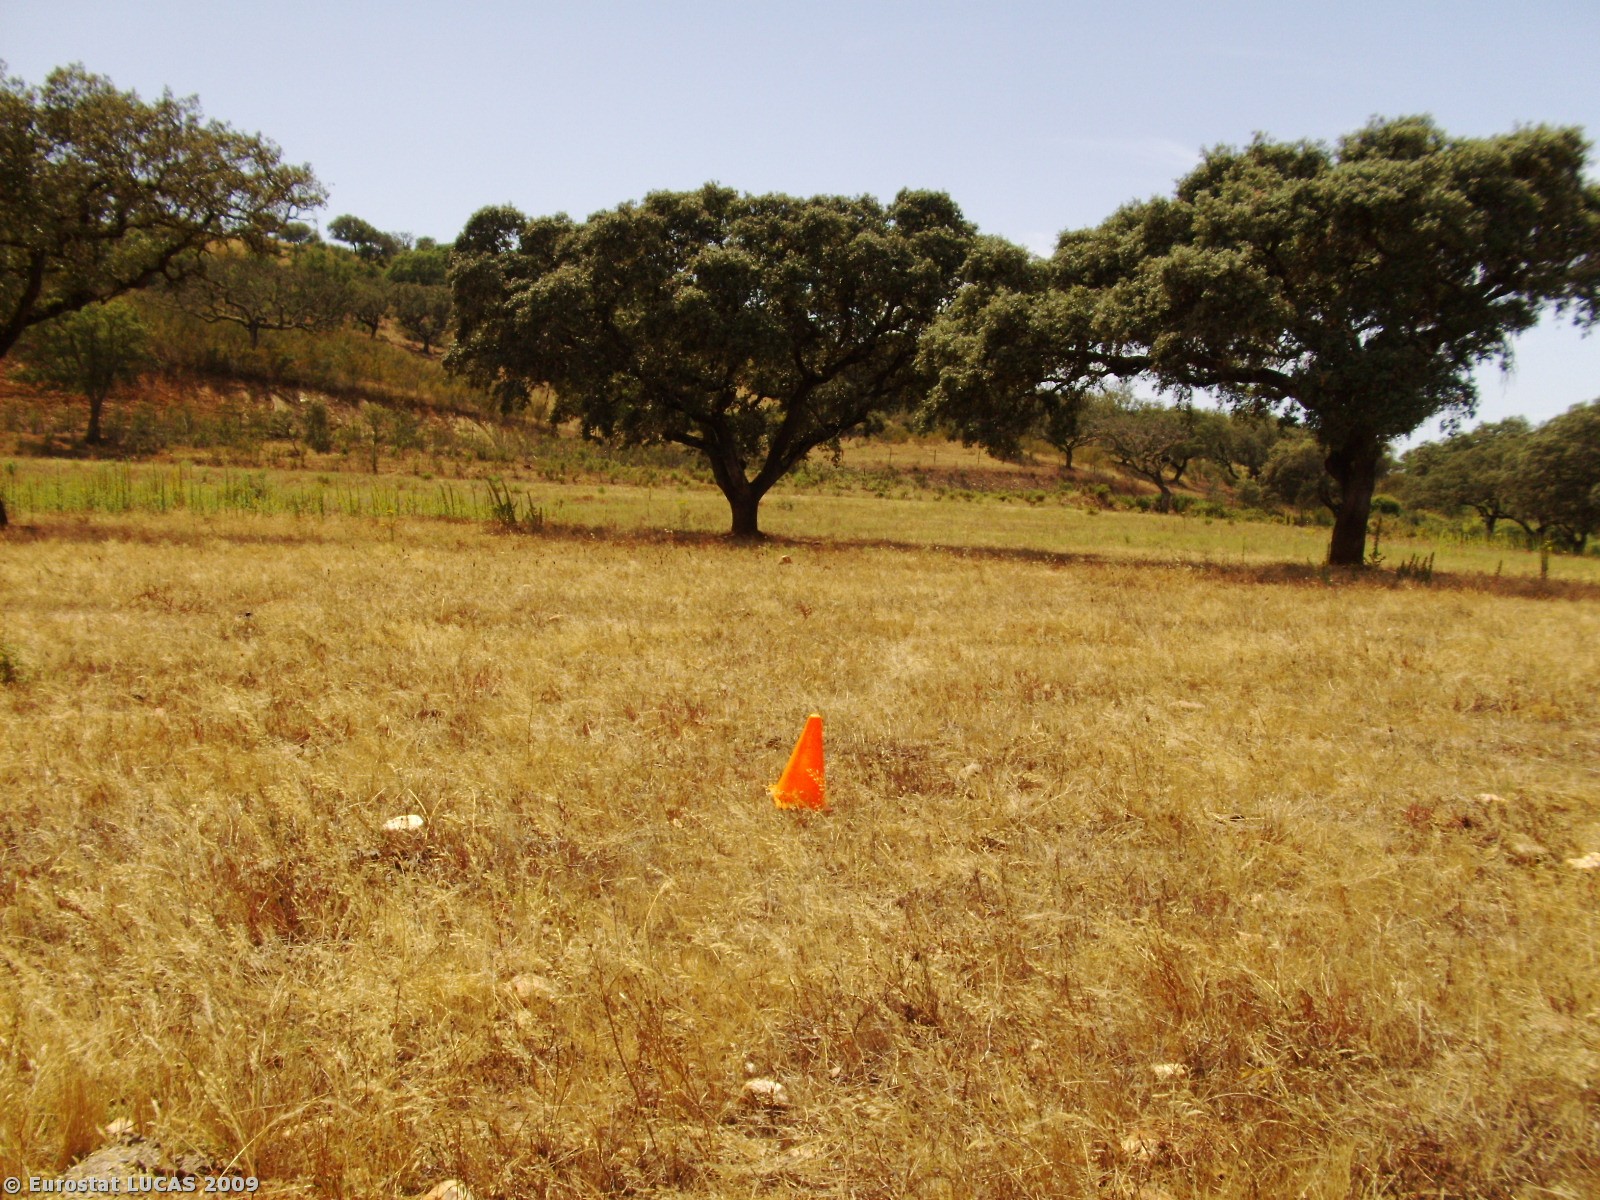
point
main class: Woodland
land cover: Broadleaved woodland
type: broadleaved evergreen forest
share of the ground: 10 - 25 %
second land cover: Spontaneously vegetated surfaces
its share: 50 - 75 %
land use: Forestry
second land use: Fallow land
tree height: > 5 m
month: June
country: PT
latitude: 37.5167
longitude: -8.5553
